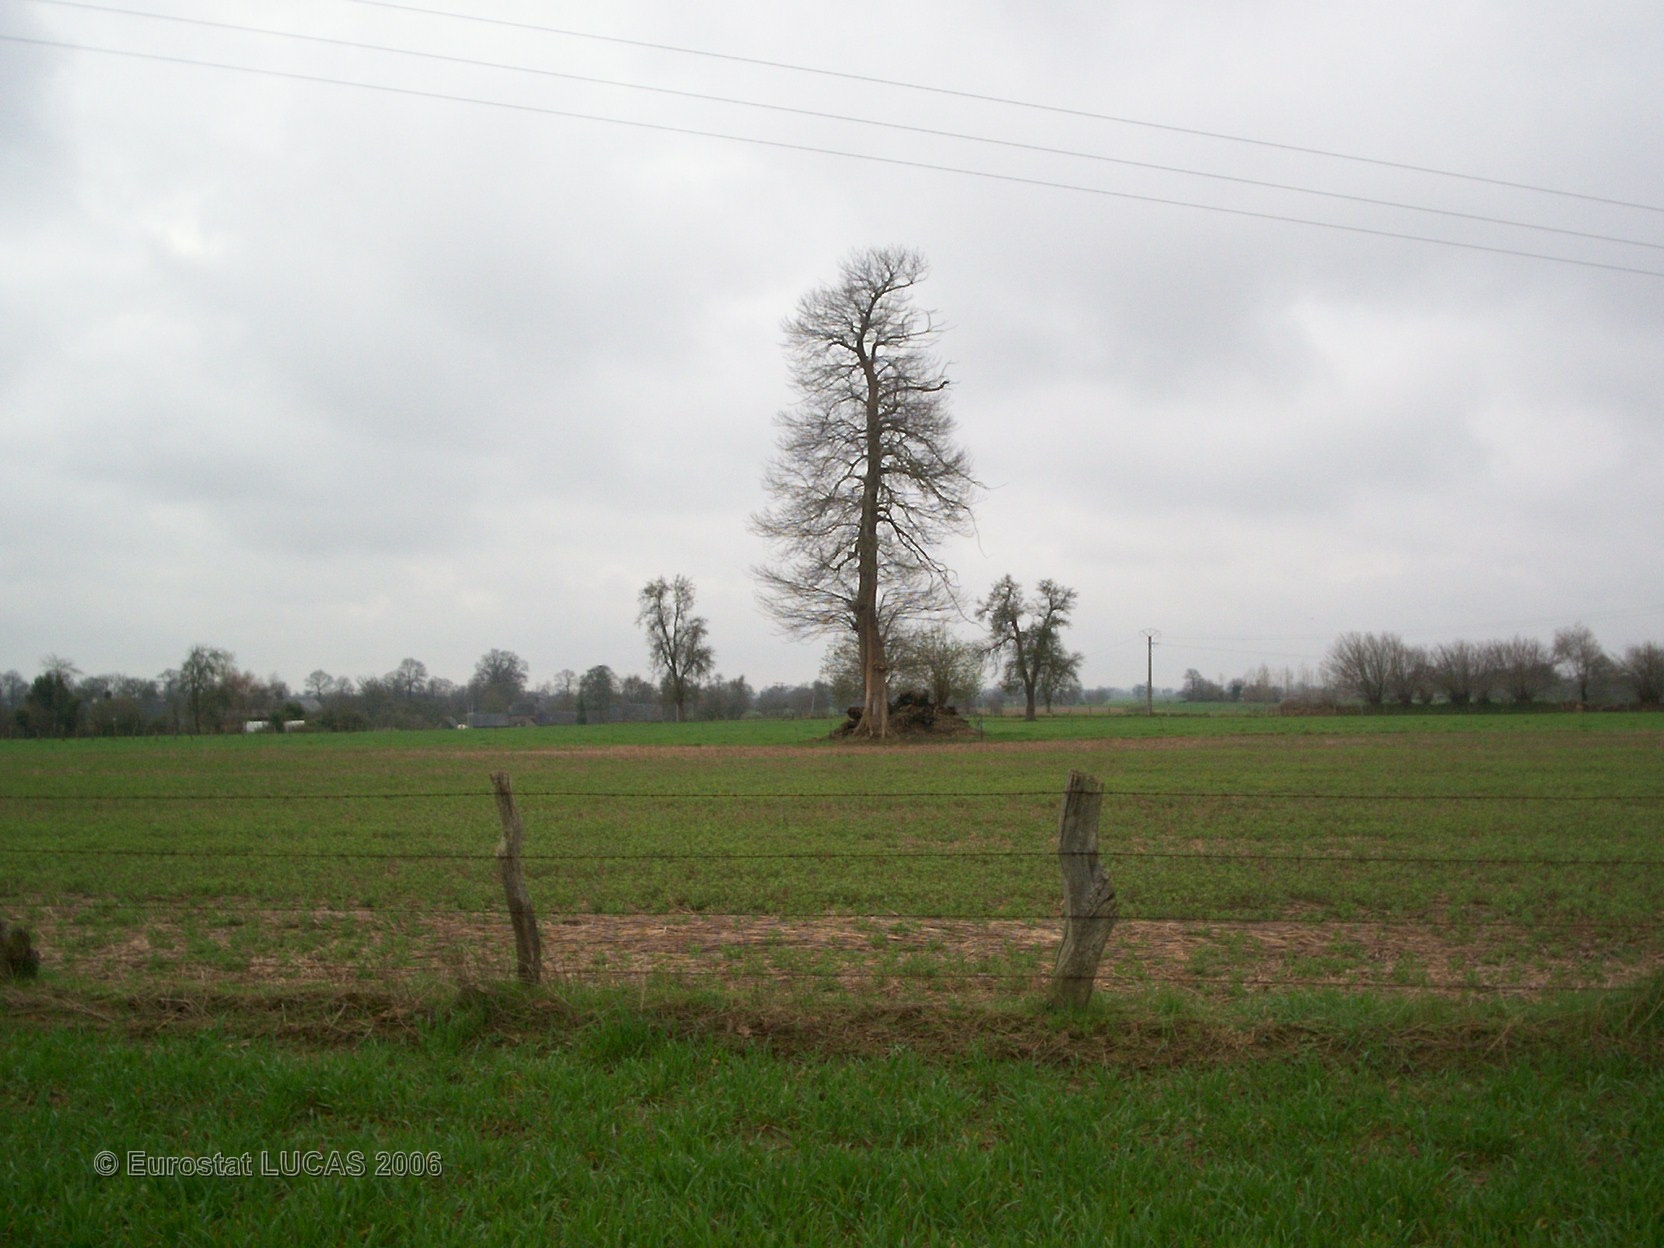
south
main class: Cropland
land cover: Common wheat
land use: Agriculture (excluding fallow land and kitchen gardens)
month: April
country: FR
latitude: 48.4450
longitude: -0.7035
